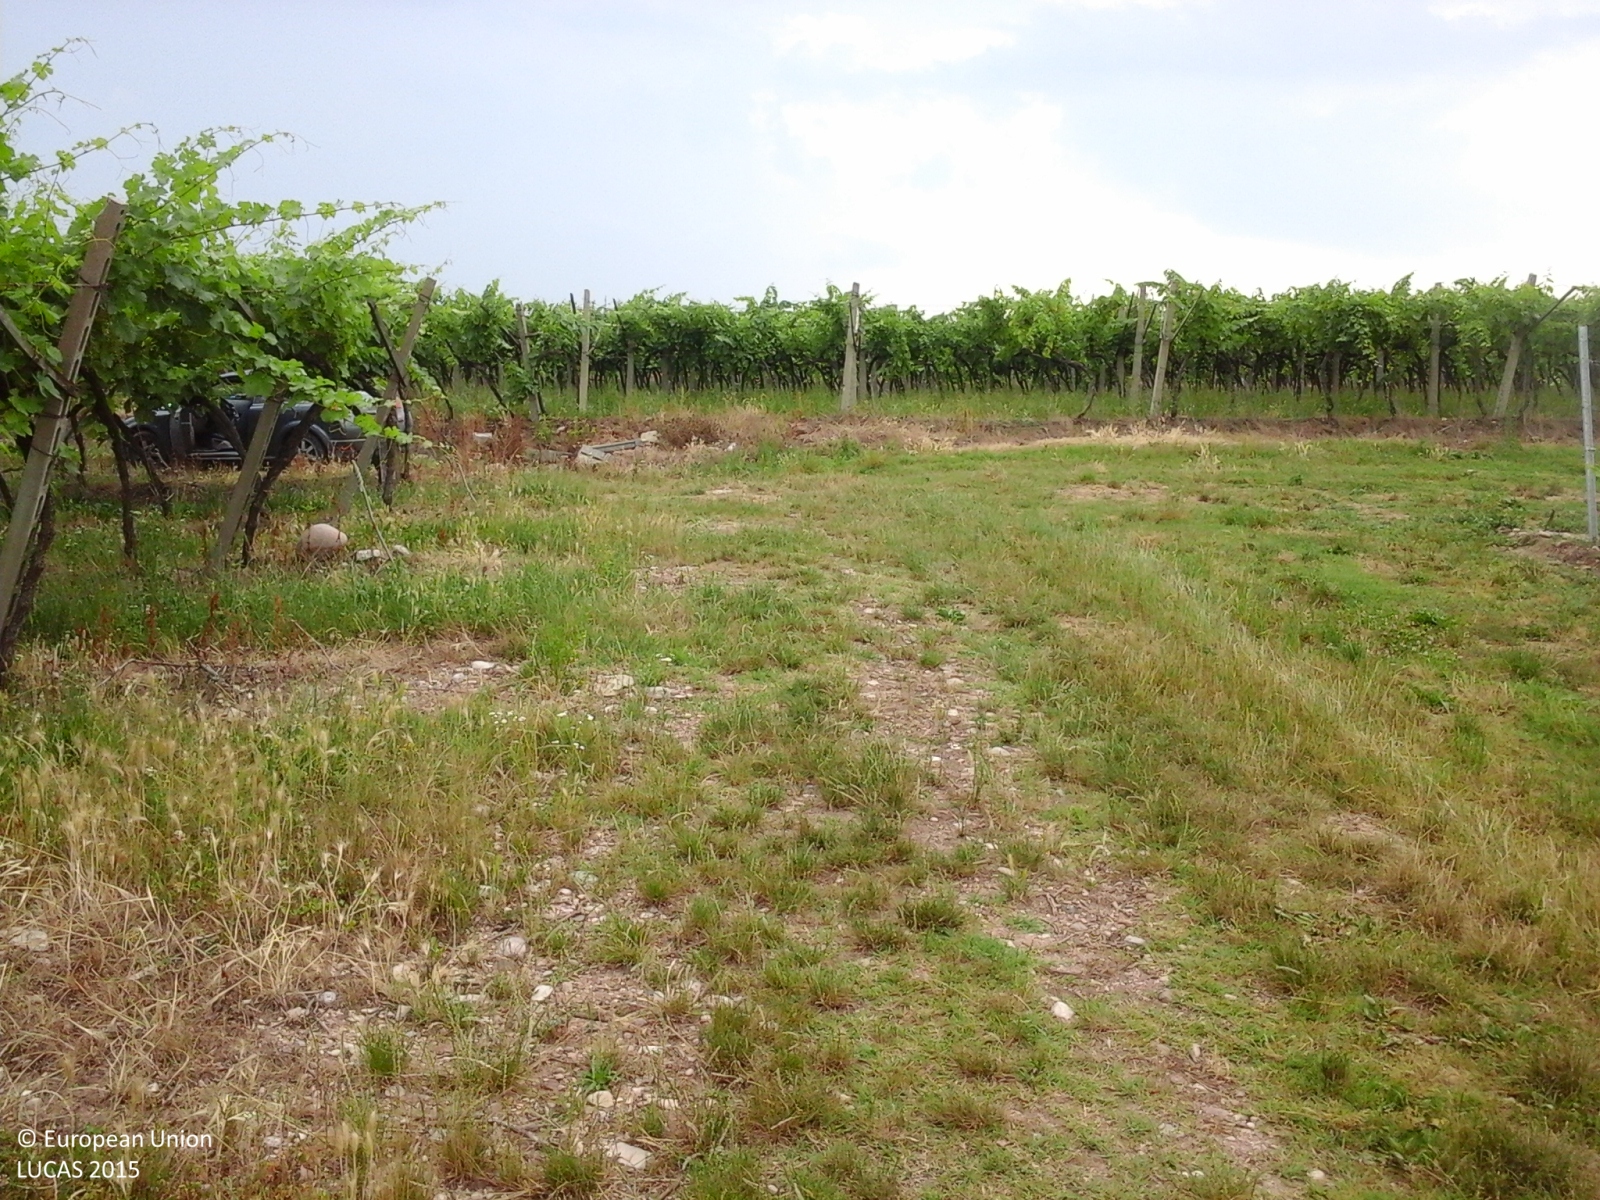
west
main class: Cropland
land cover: Vineyards
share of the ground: > 75 %
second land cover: Grassland without tree/shrub cover
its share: > 75 %
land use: Agriculture (excluding fallow land and kitchen gardens)
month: June
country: IT
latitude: 45.4293
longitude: 10.8039
